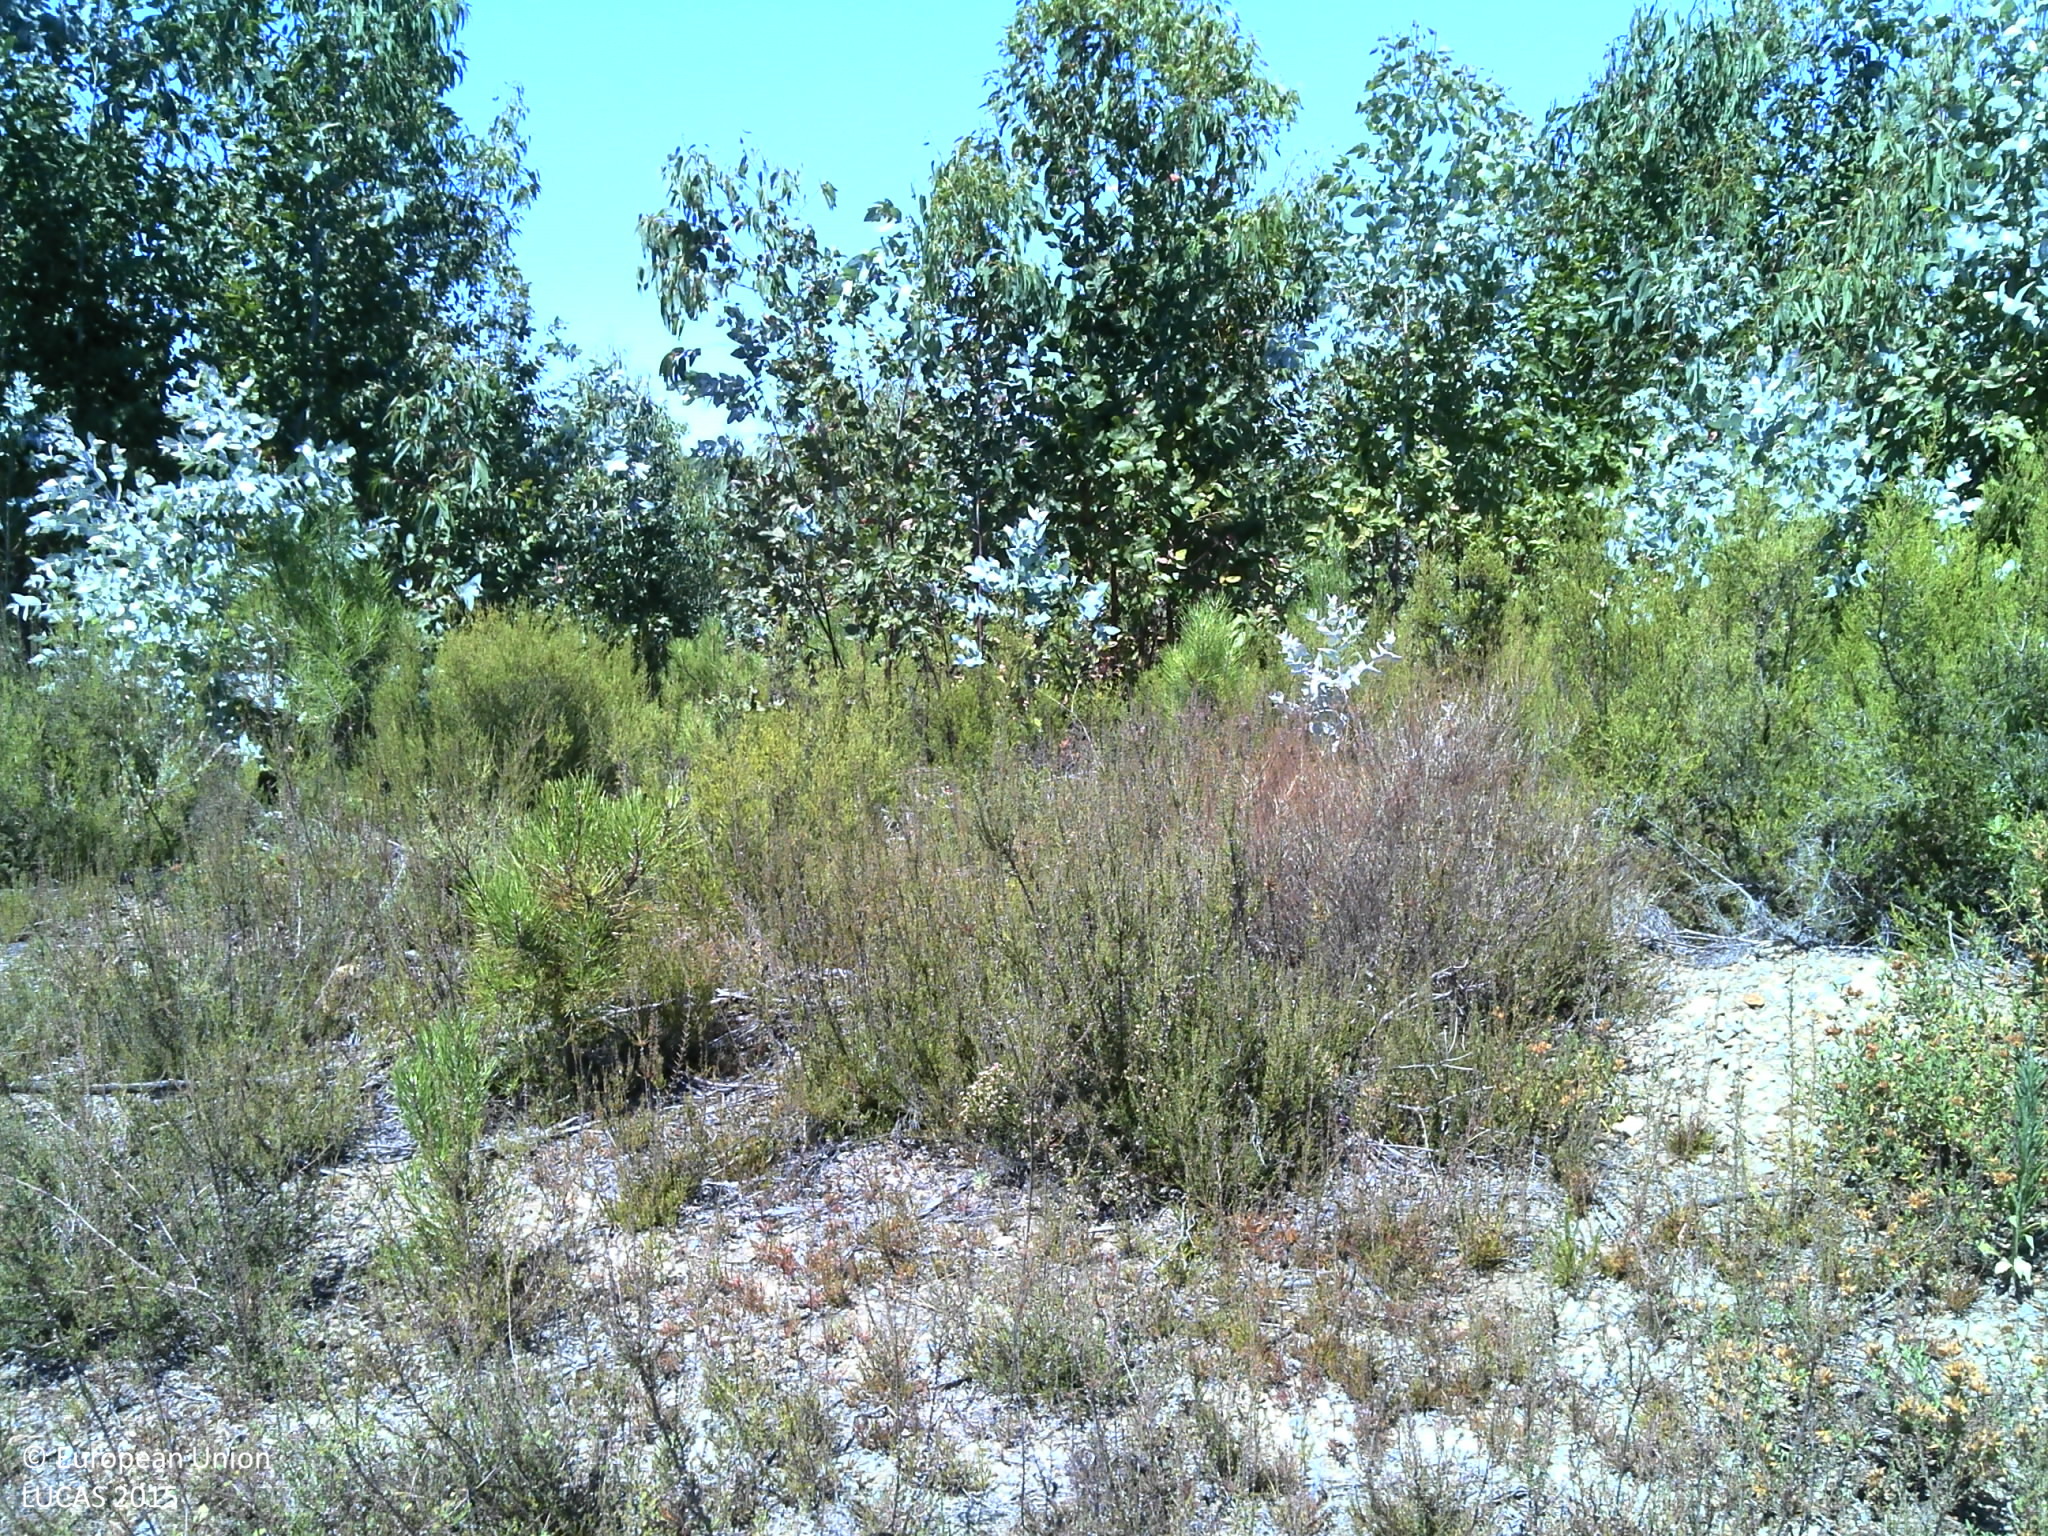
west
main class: Cropland
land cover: Vineyards
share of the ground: 25 - 50 %
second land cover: Grassland without tree/shrub cover
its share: 10 - 25 %
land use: Agriculture (excluding fallow land and kitchen gardens)
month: July
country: PT
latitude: 39.8257
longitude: -8.0955
